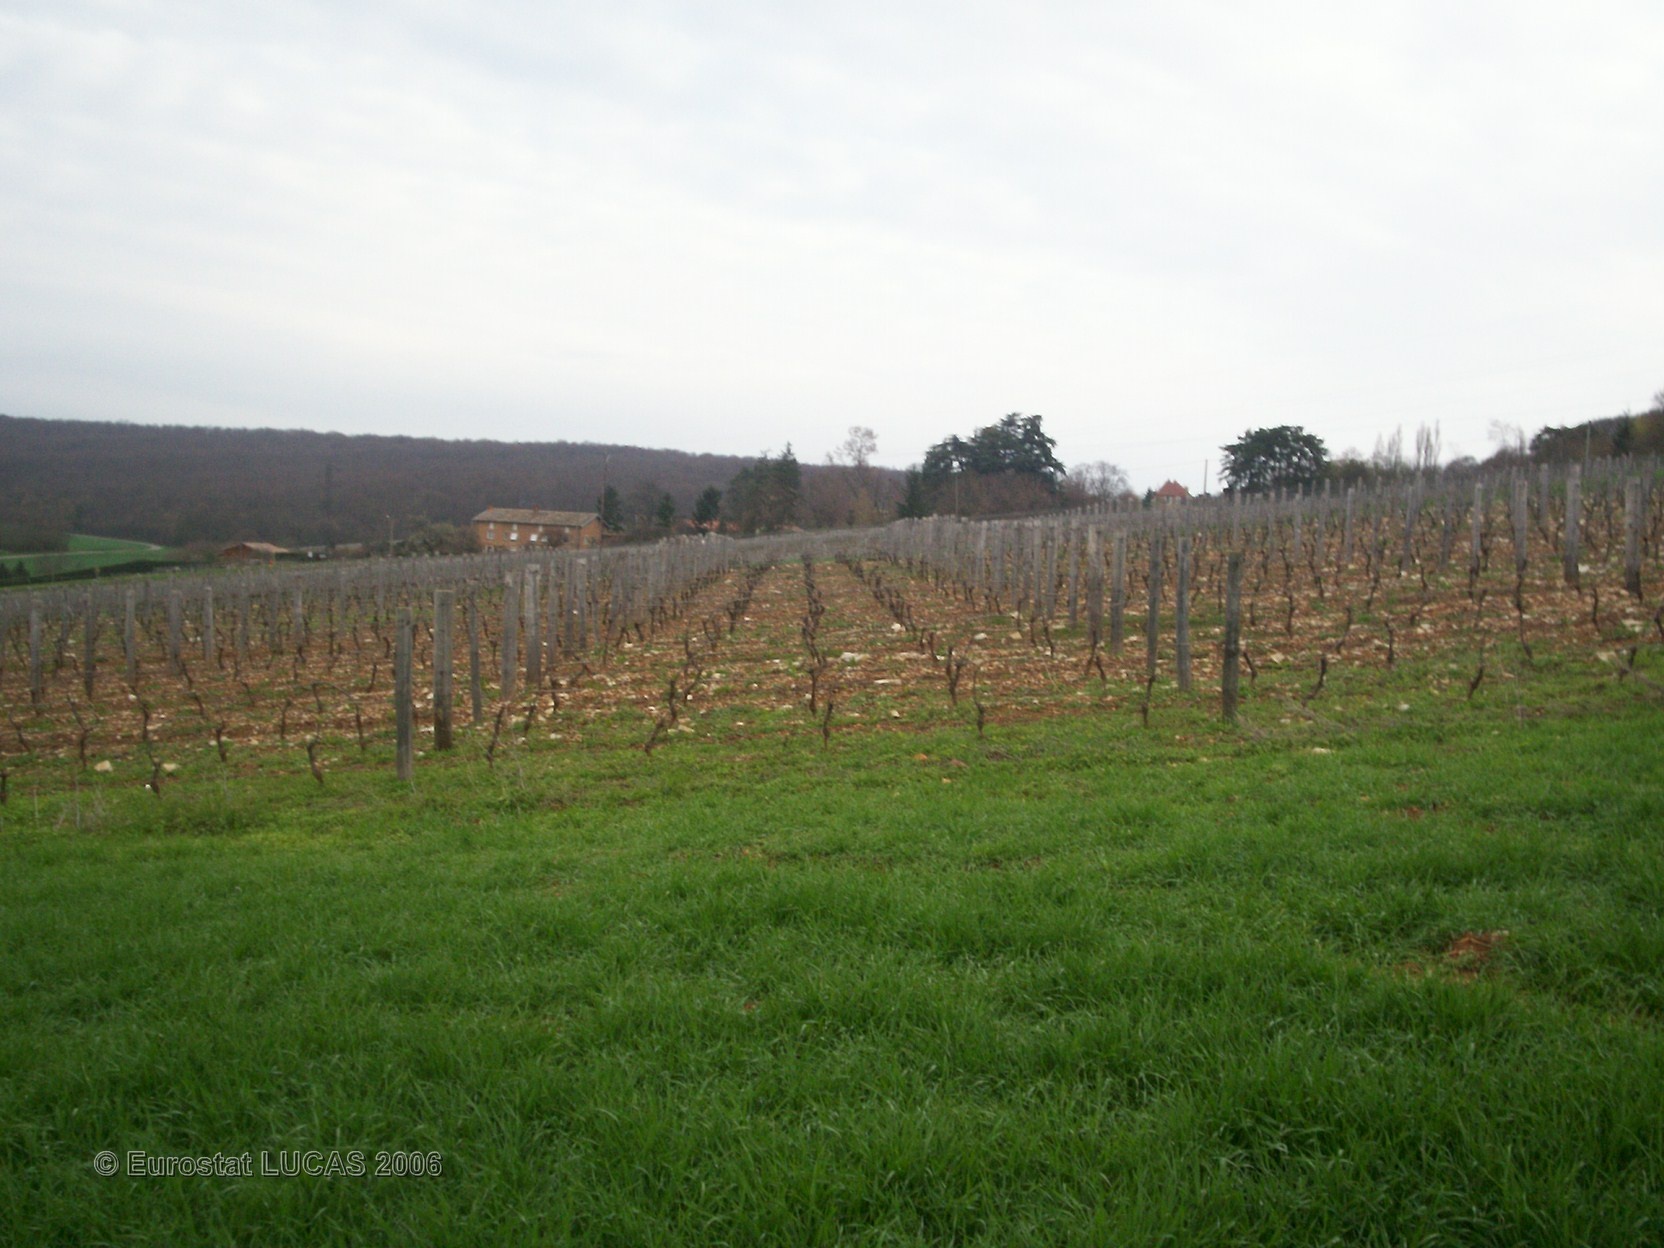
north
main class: Cropland
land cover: Barley
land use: Agriculture (excluding fallow land and kitchen gardens)
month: April
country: FR
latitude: 46.3494
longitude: 4.7653
